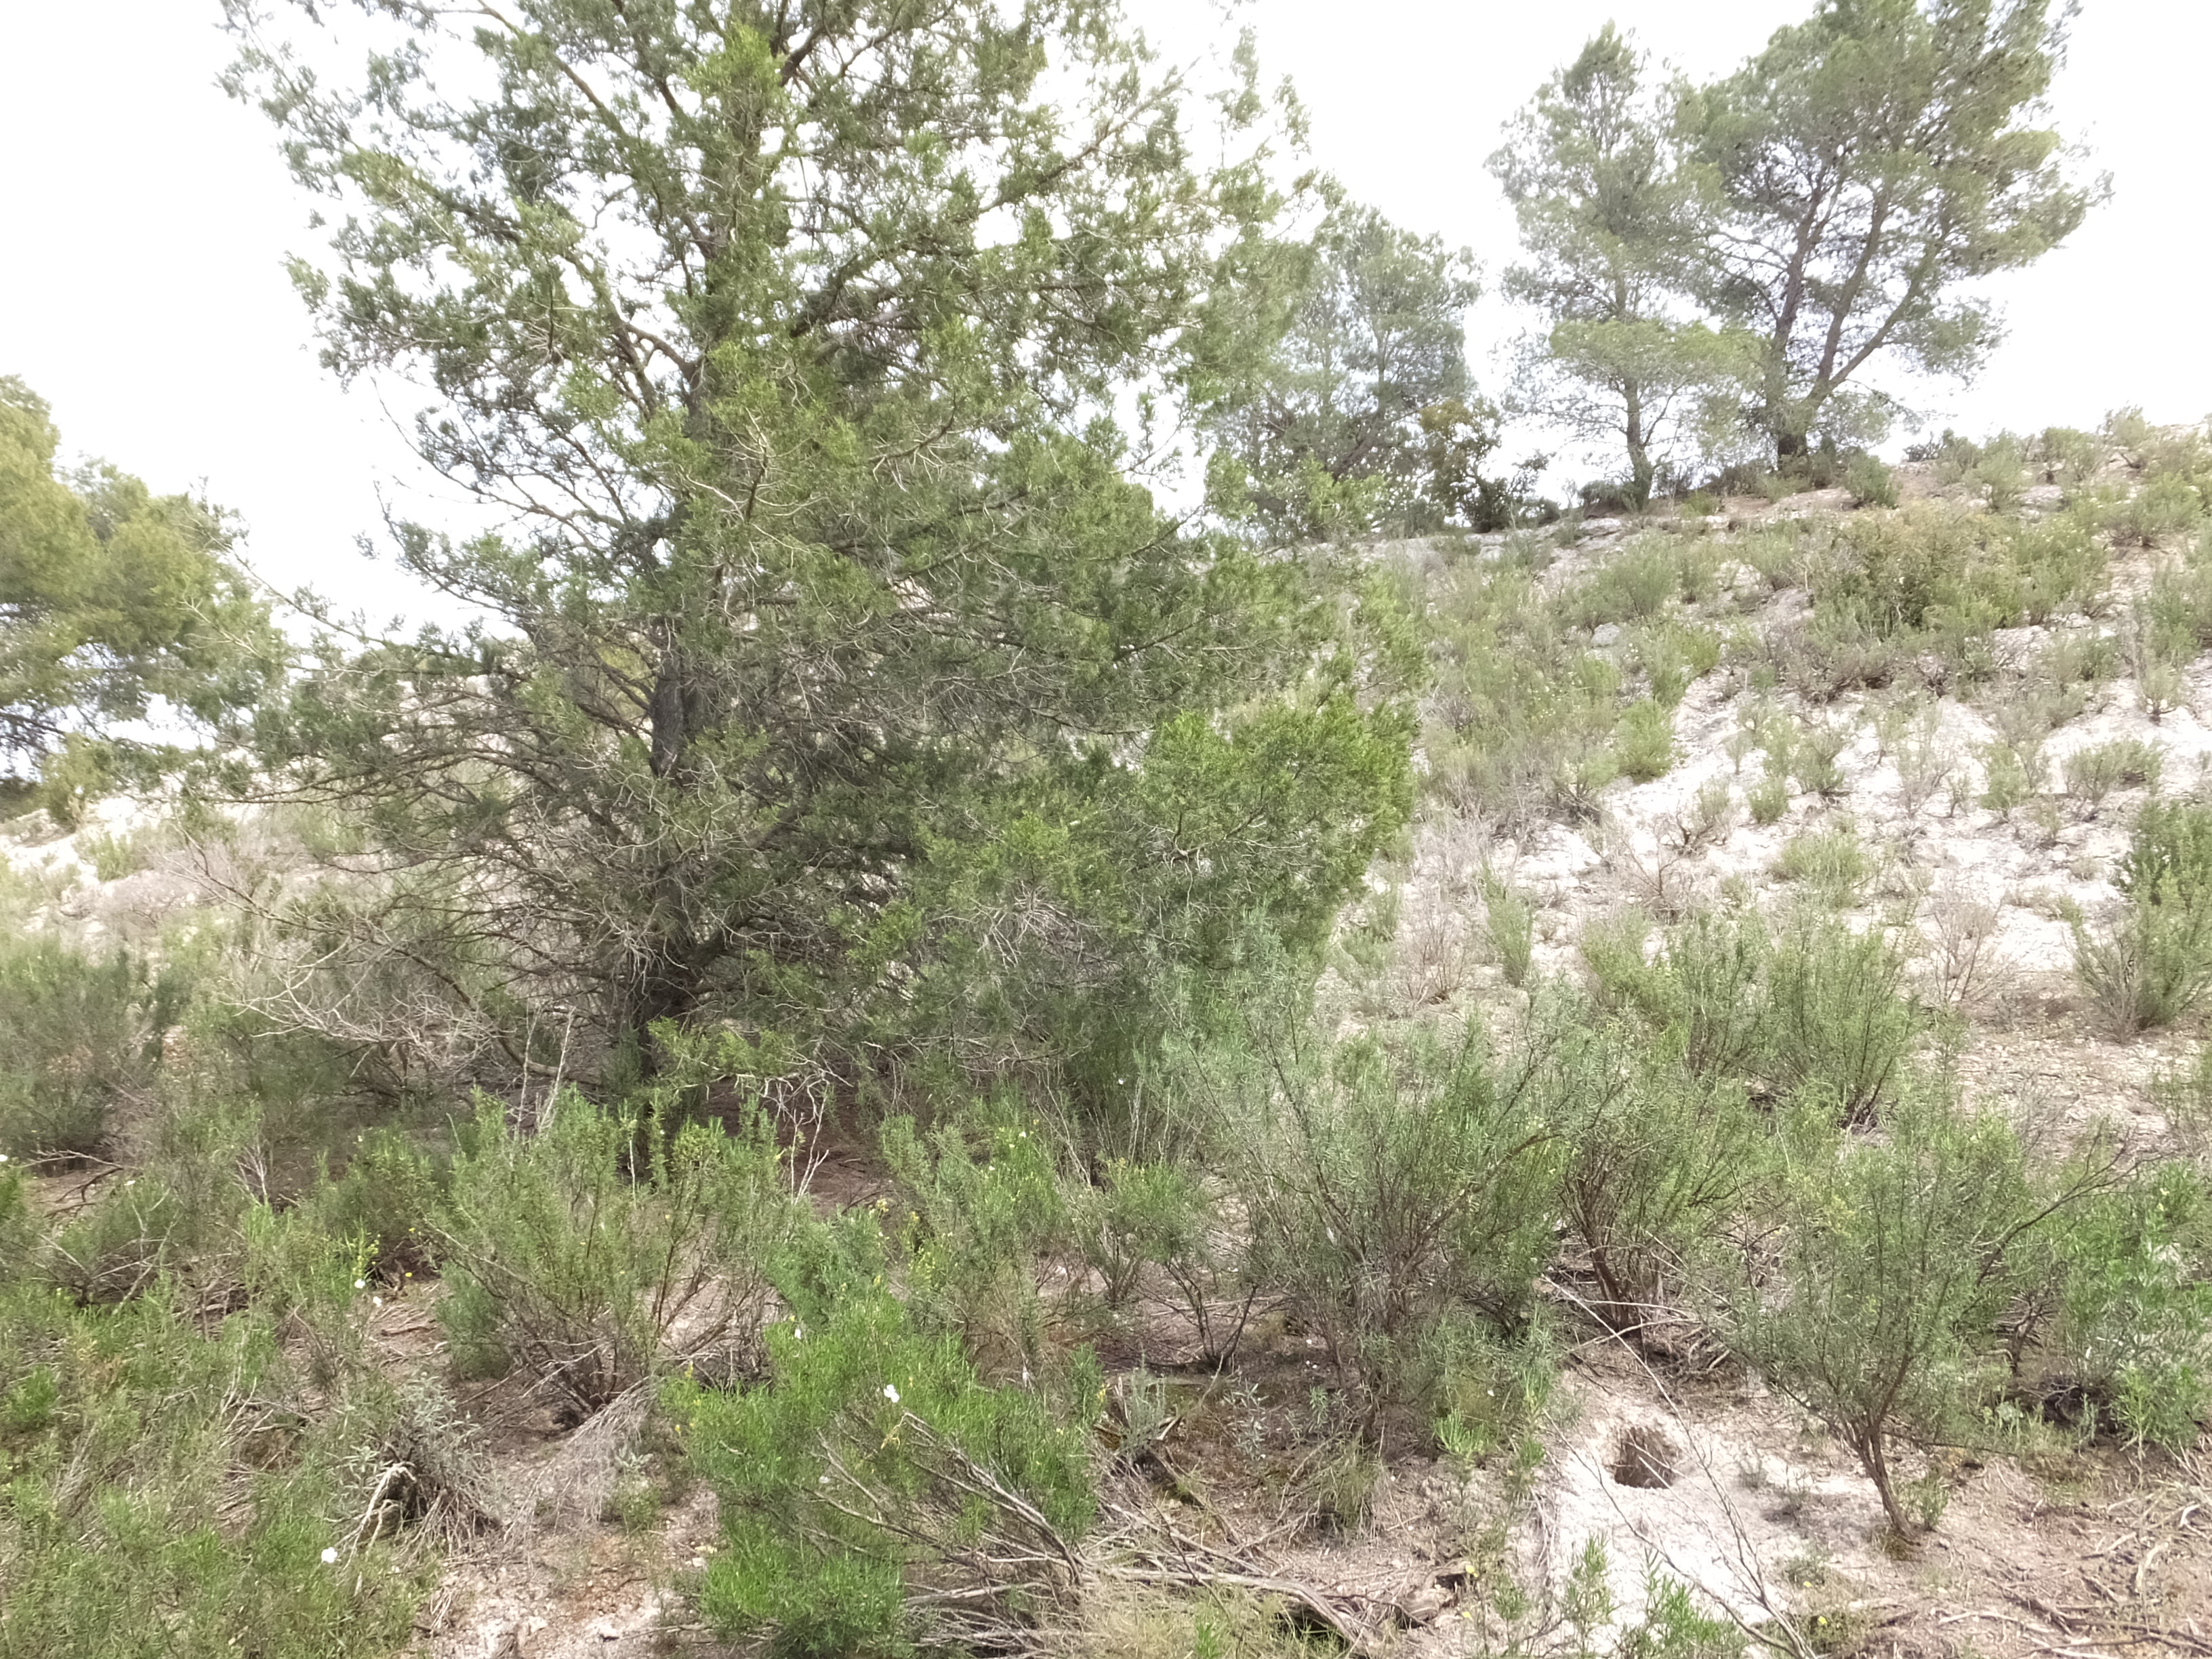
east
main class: Woodland
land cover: Pine dominated mixed woodland
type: coniferous forest of the mediterranean region
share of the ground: 50 - 75 %
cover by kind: coniferous forest trees 60 %, broadleaved forest trees 20 %, shrubs 20 %
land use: Forestry
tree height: > 5 m
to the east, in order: Pine dominated mixed woodland; Shrubland with sparse tree cover; Other bare soil; Shruby margins; Other bare soil; Shruby margins; Tracks; Shrubland without tree cover
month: May
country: ES
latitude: 41.4747
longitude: -0.2784
